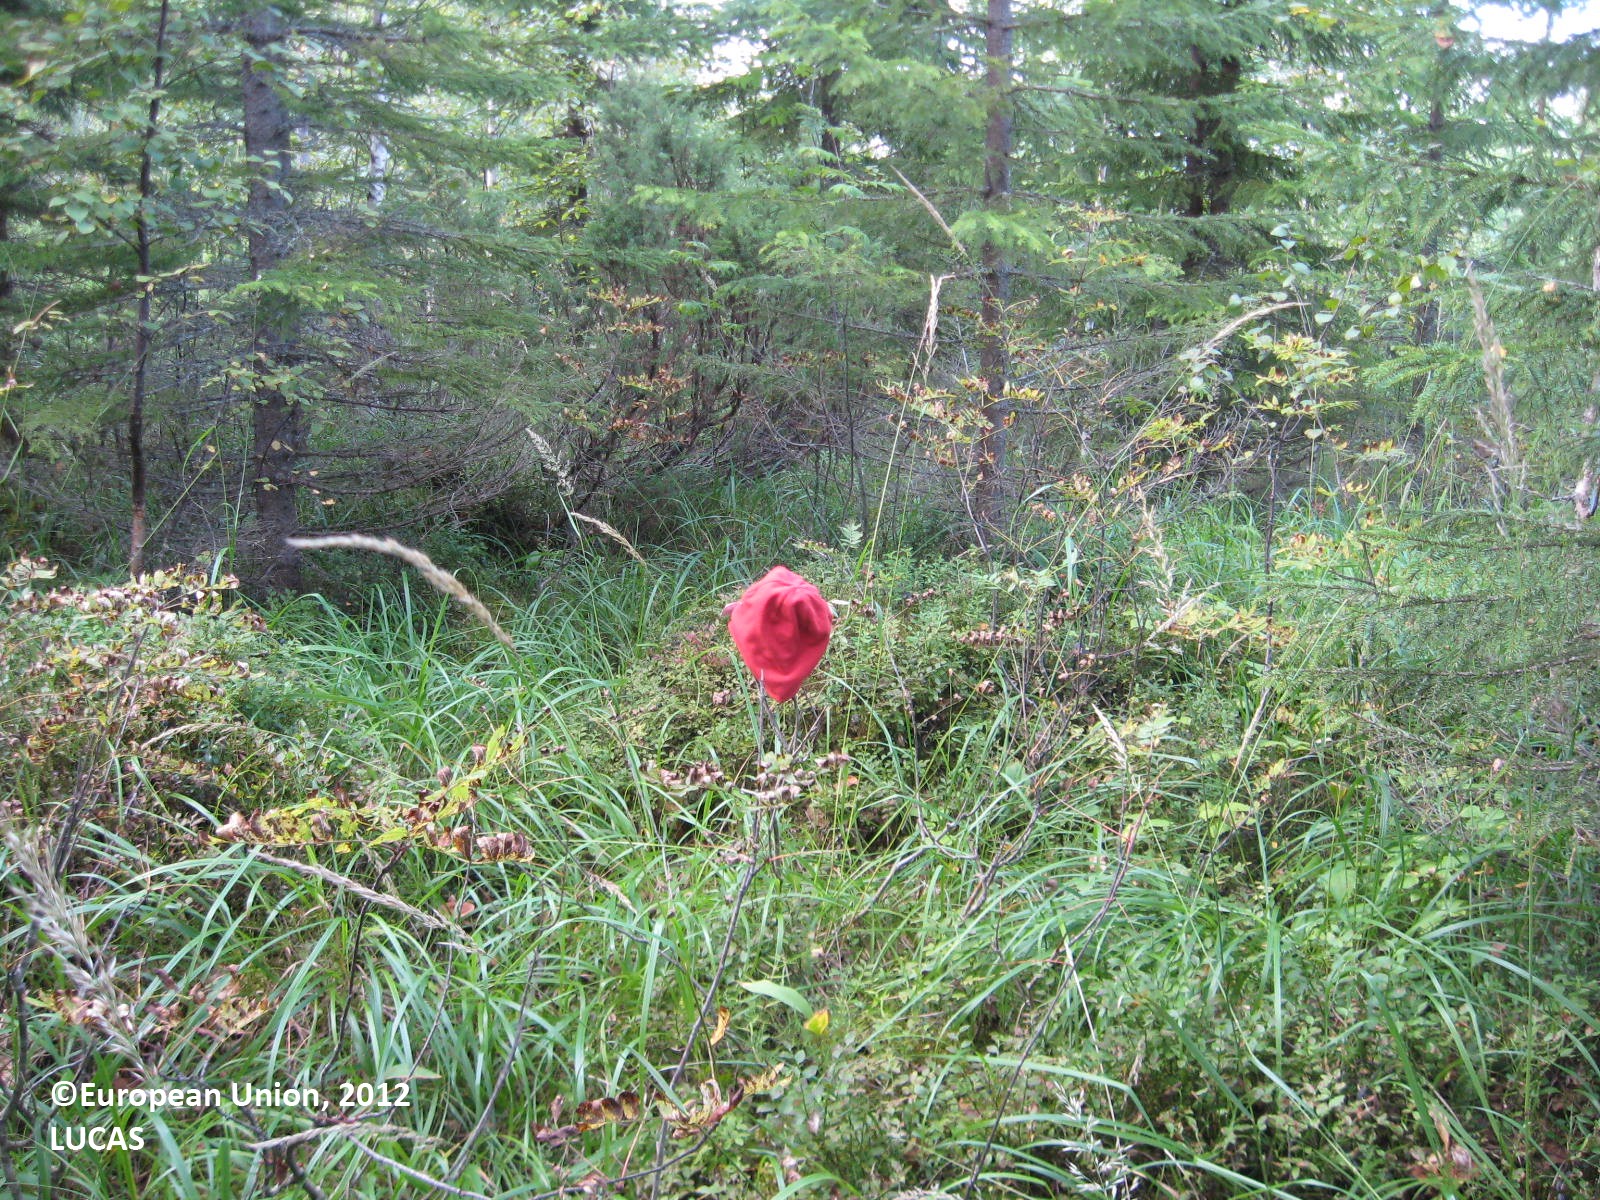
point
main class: Woodland
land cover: Other mixed woodland
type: boreal forest
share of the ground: > 75 %
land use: Forestry
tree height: > 5 m
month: August
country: FI
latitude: 63.5959
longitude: 29.8095
